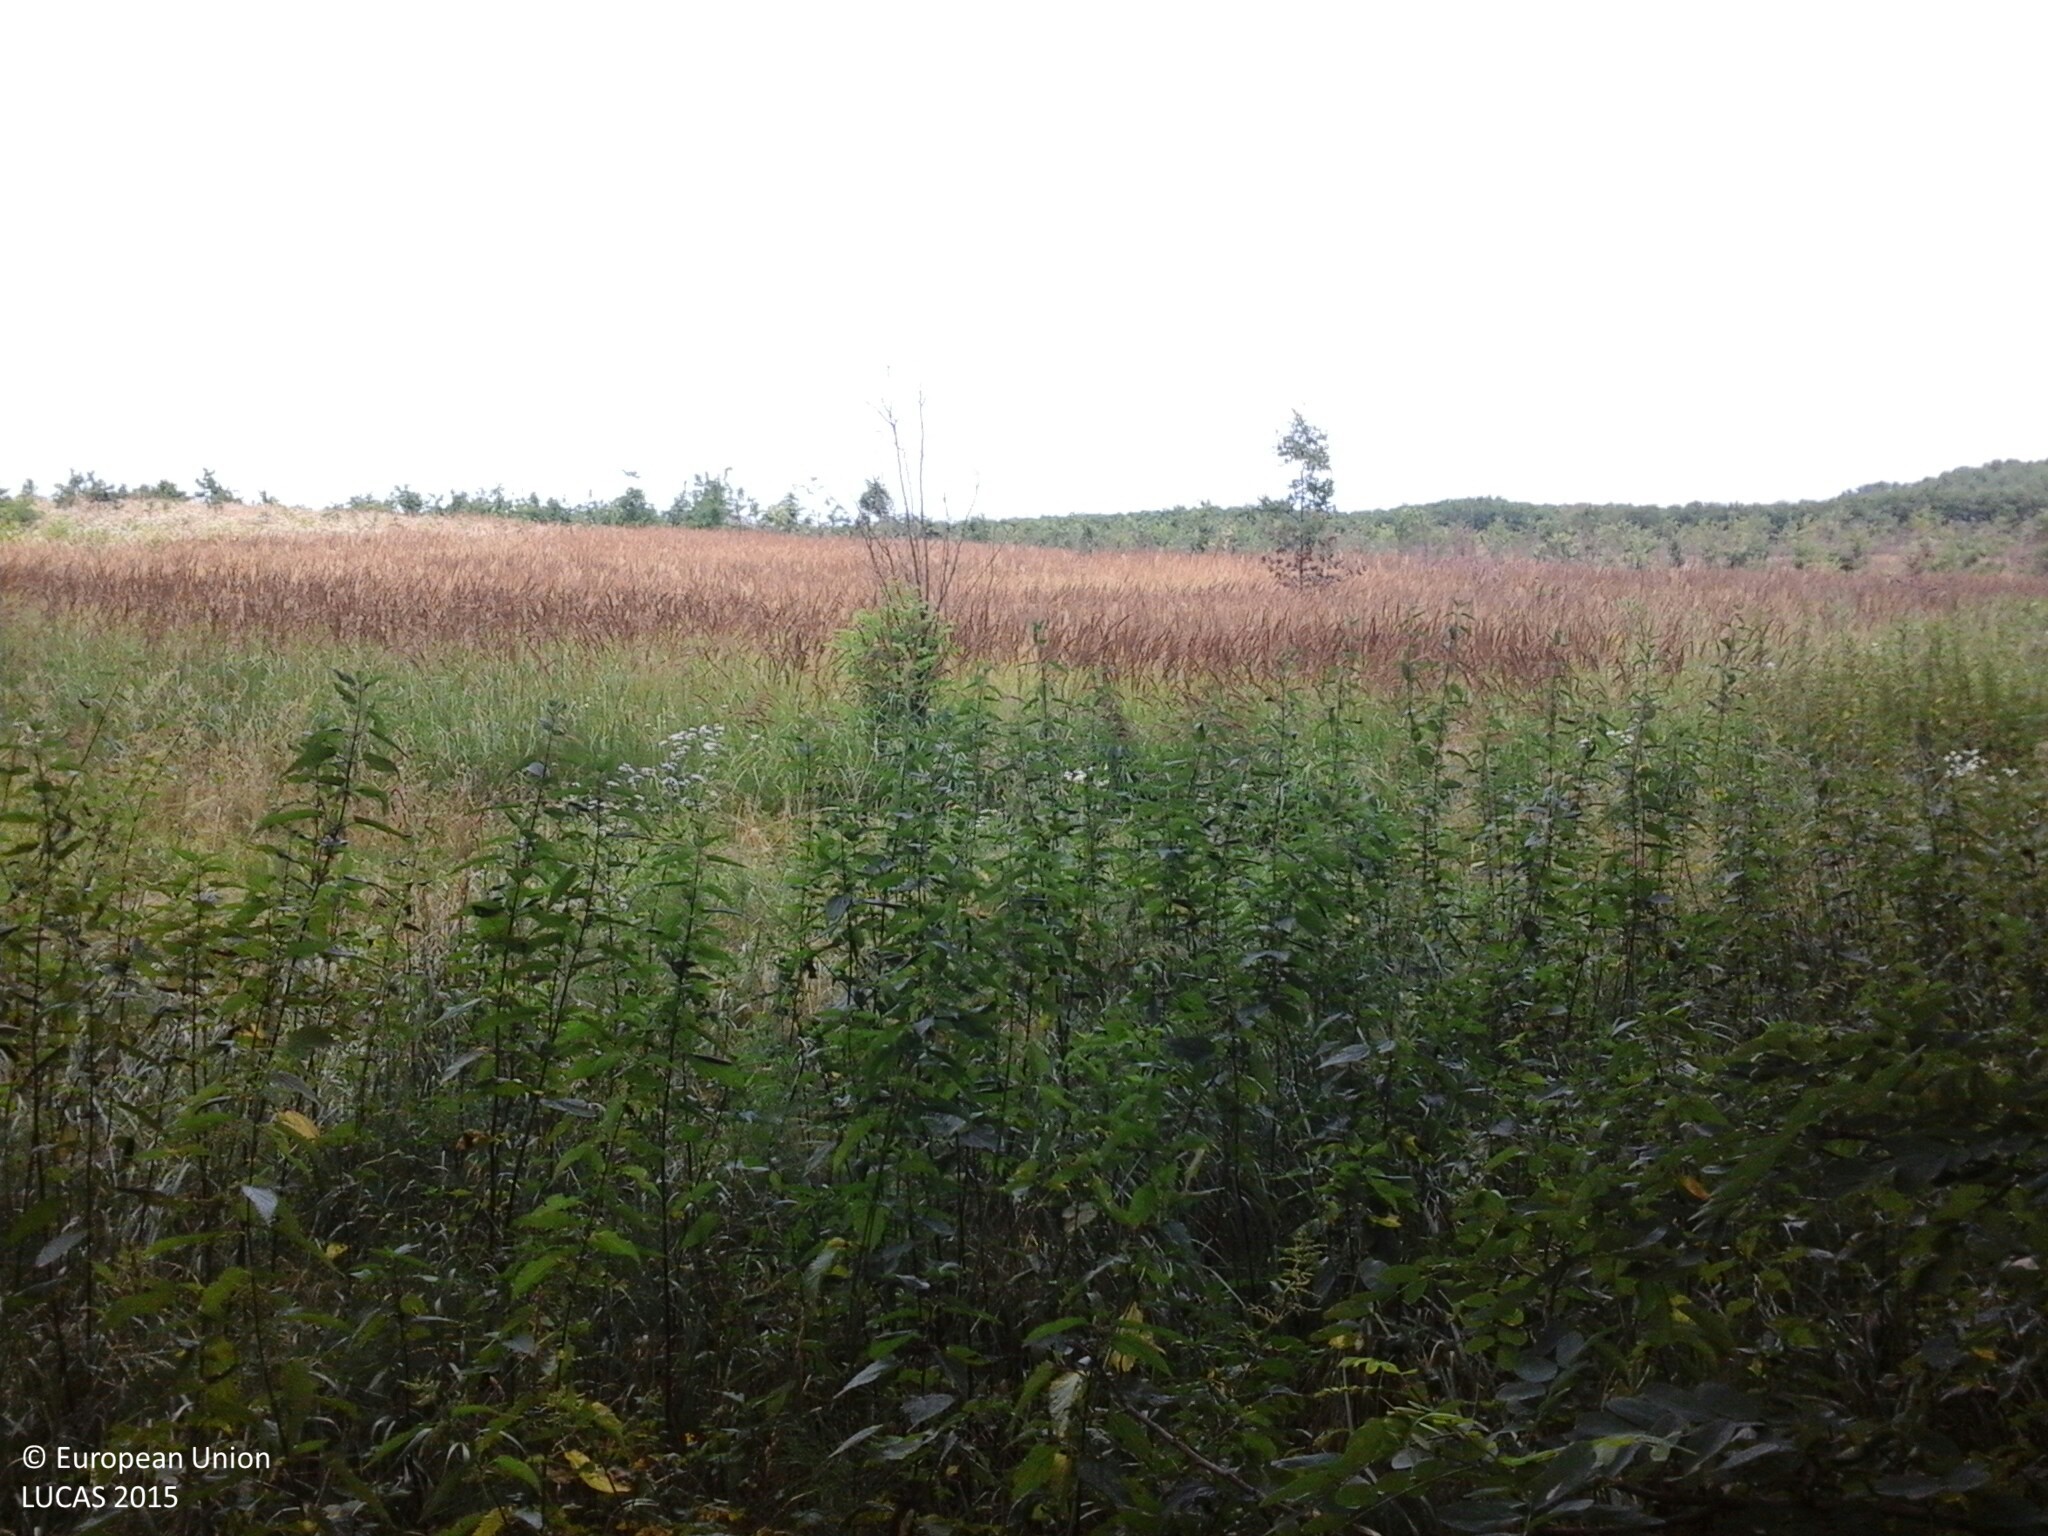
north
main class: Woodland
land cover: Broadleaved woodland
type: mesophytic deciduous forest
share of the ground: > 75 %
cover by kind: broadleaved forest trees 90 %, herbaceous plants 10 %
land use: Forestry
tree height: > 5 m
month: July
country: HU
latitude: 48.3628
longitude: 22.0261
